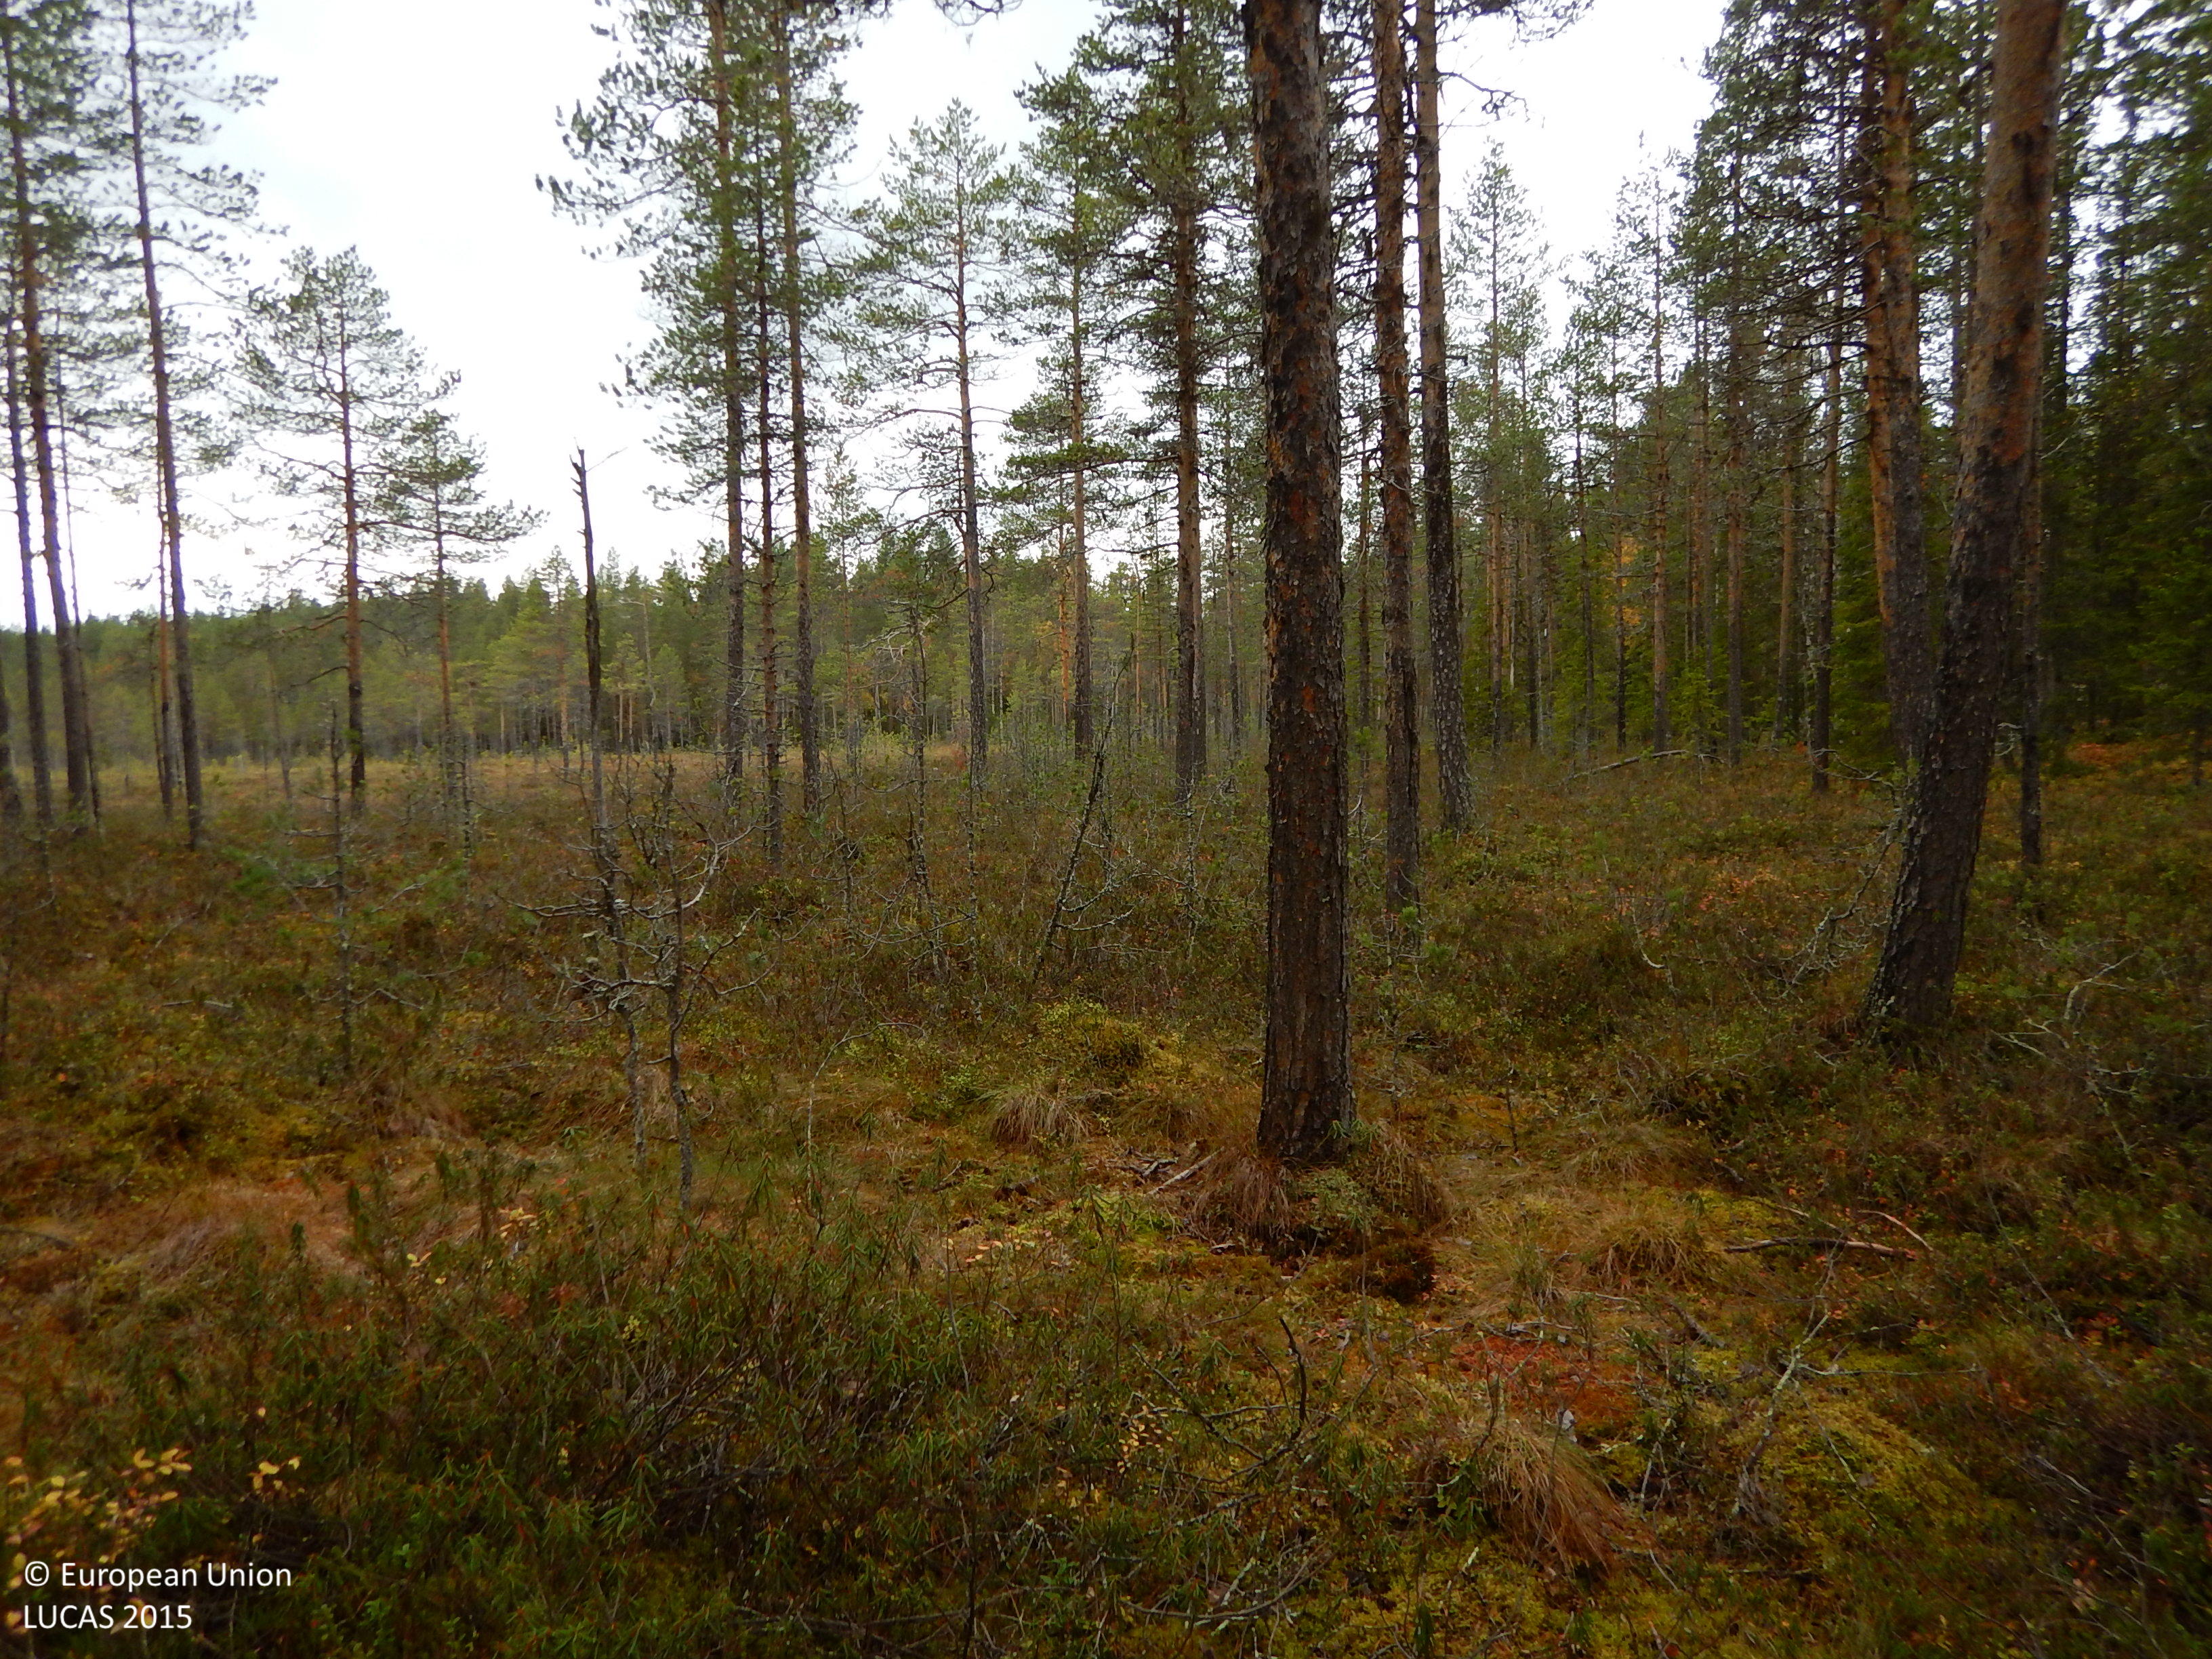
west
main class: Woodland
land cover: Pine dominated coniferous woodland
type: boreal forest
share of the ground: 50 - 75 %
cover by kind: coniferous forest trees 55 %, shrubs 20 %, lichens and mosses 20 %, herbaceous plants 5 %
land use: Forestry
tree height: > 5 m
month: September
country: SE
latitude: 65.0945
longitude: 19.2228
